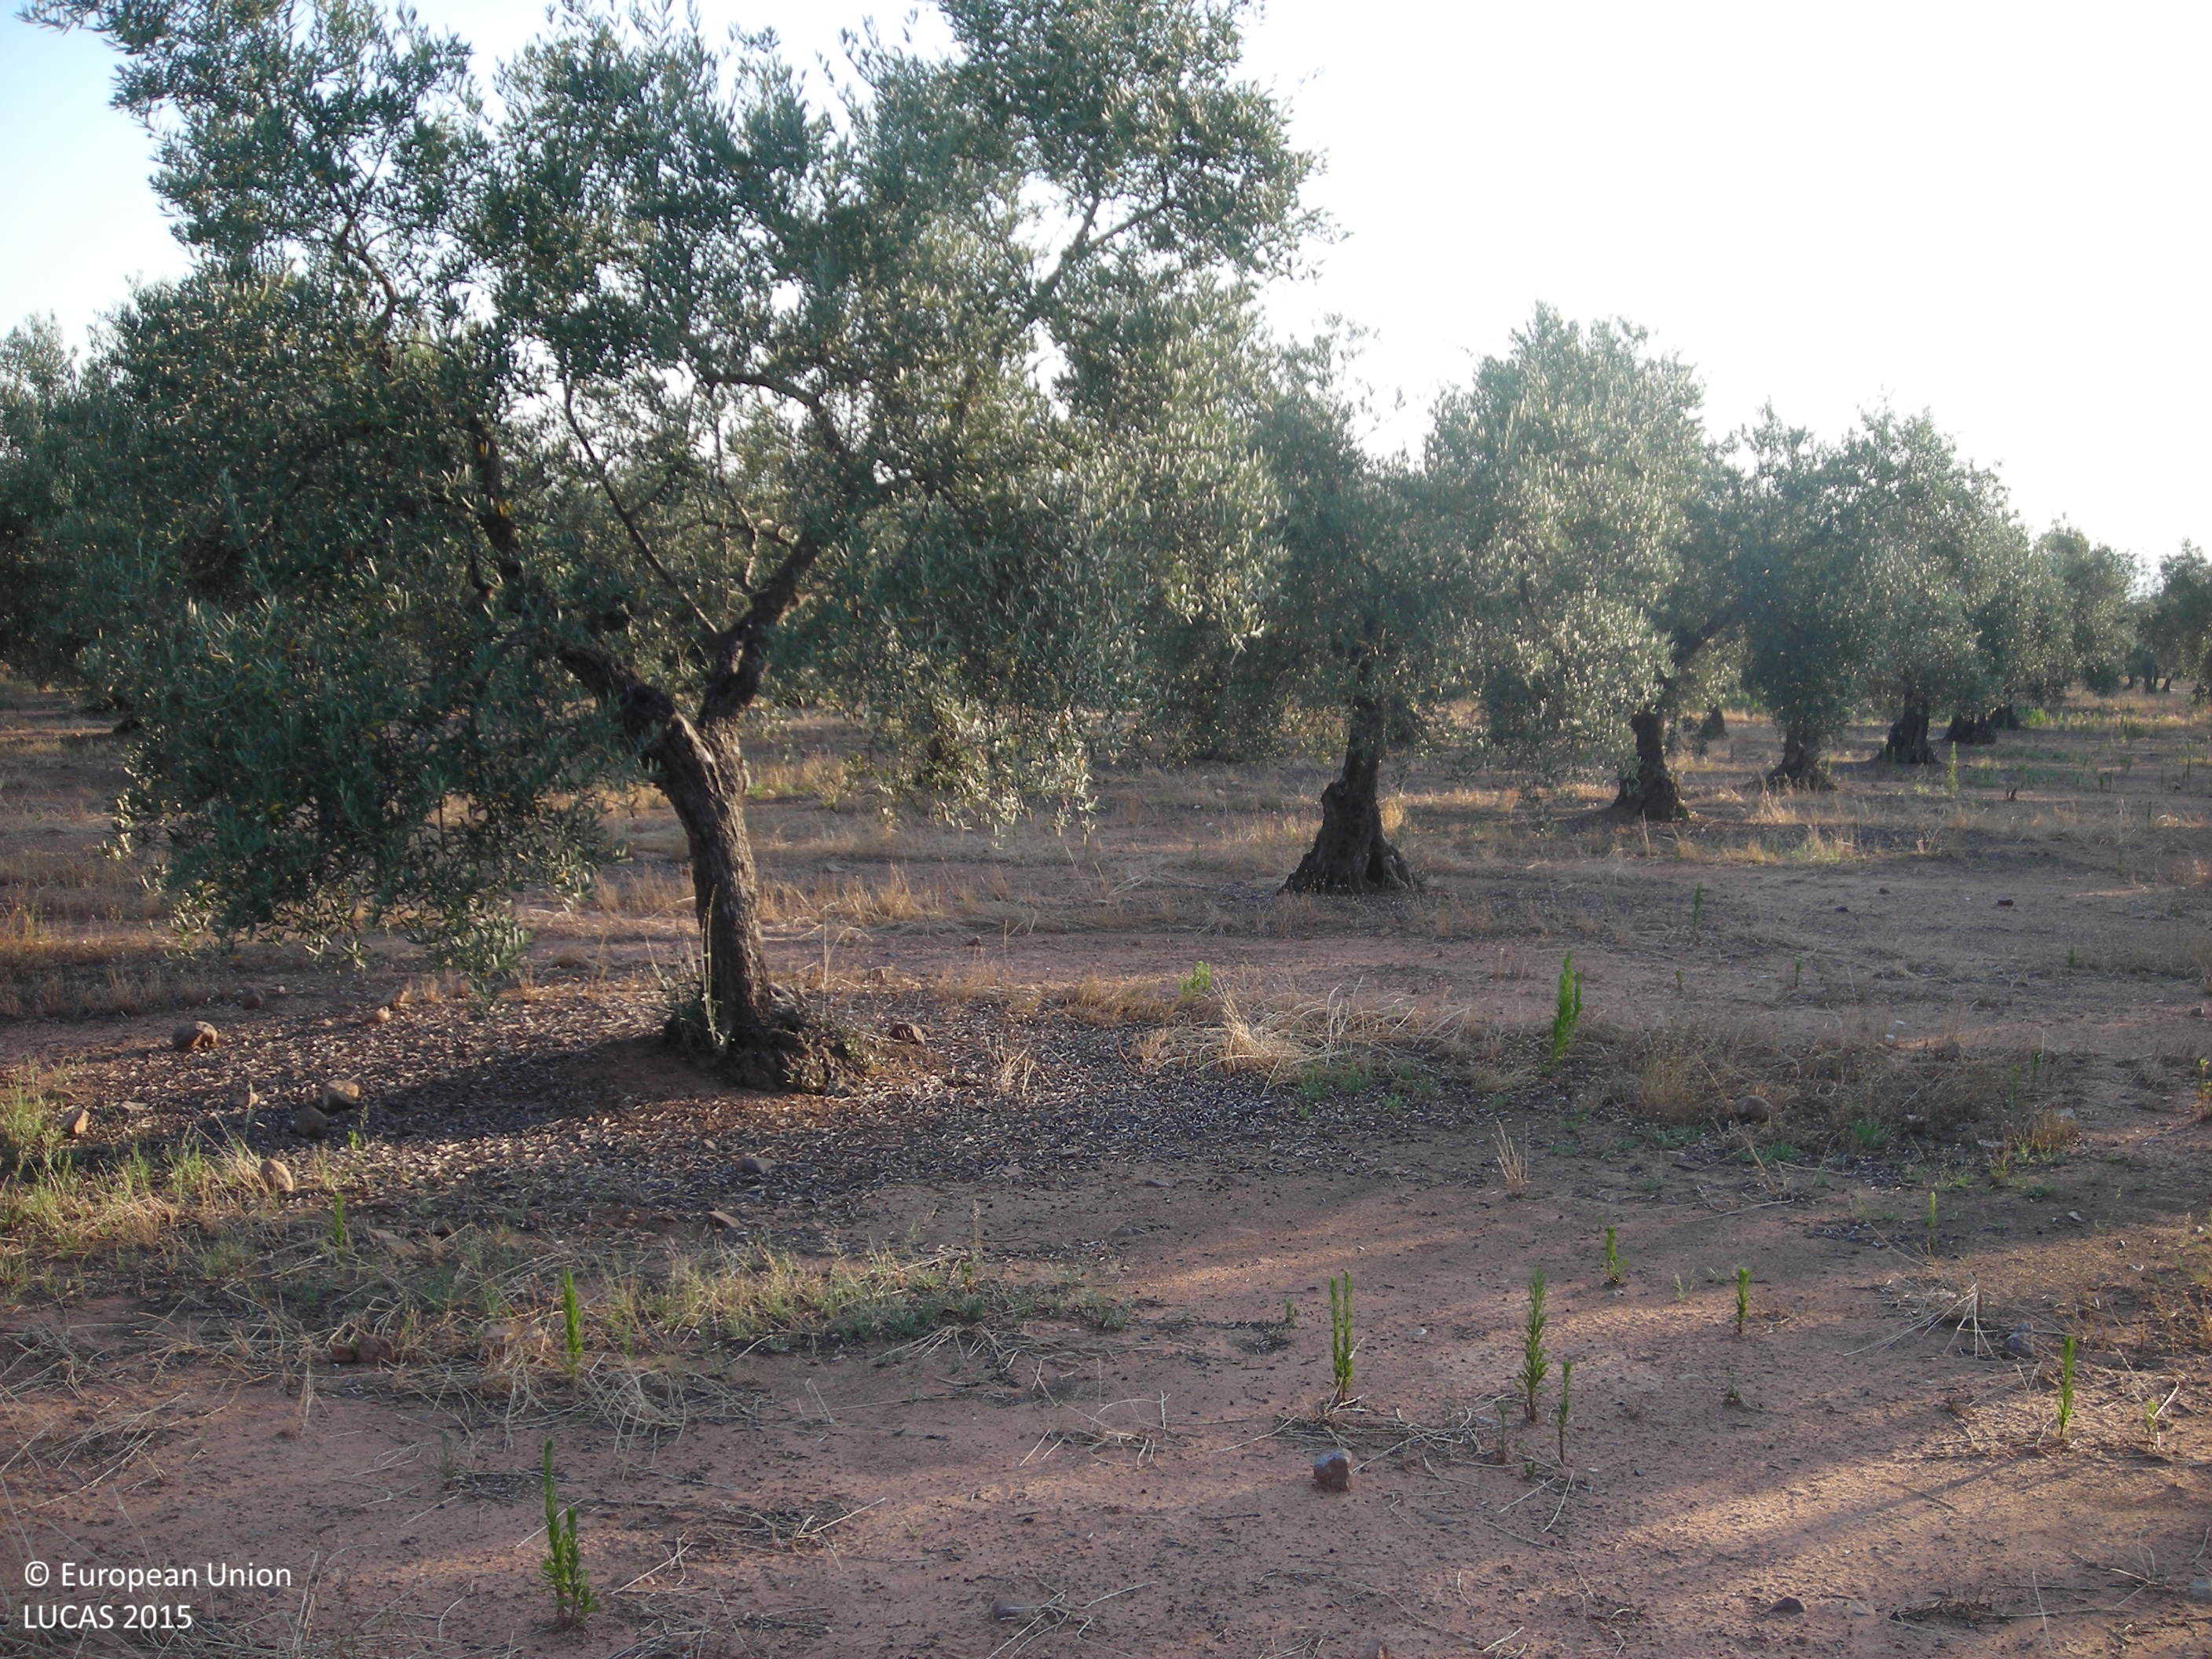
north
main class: Cropland
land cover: Olive groves
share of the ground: > 75 %
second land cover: Other bare soil
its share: > 75 %
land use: Agriculture (excluding fallow land and kitchen gardens)
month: June
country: ES
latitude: 39.0754
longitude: -5.4288
